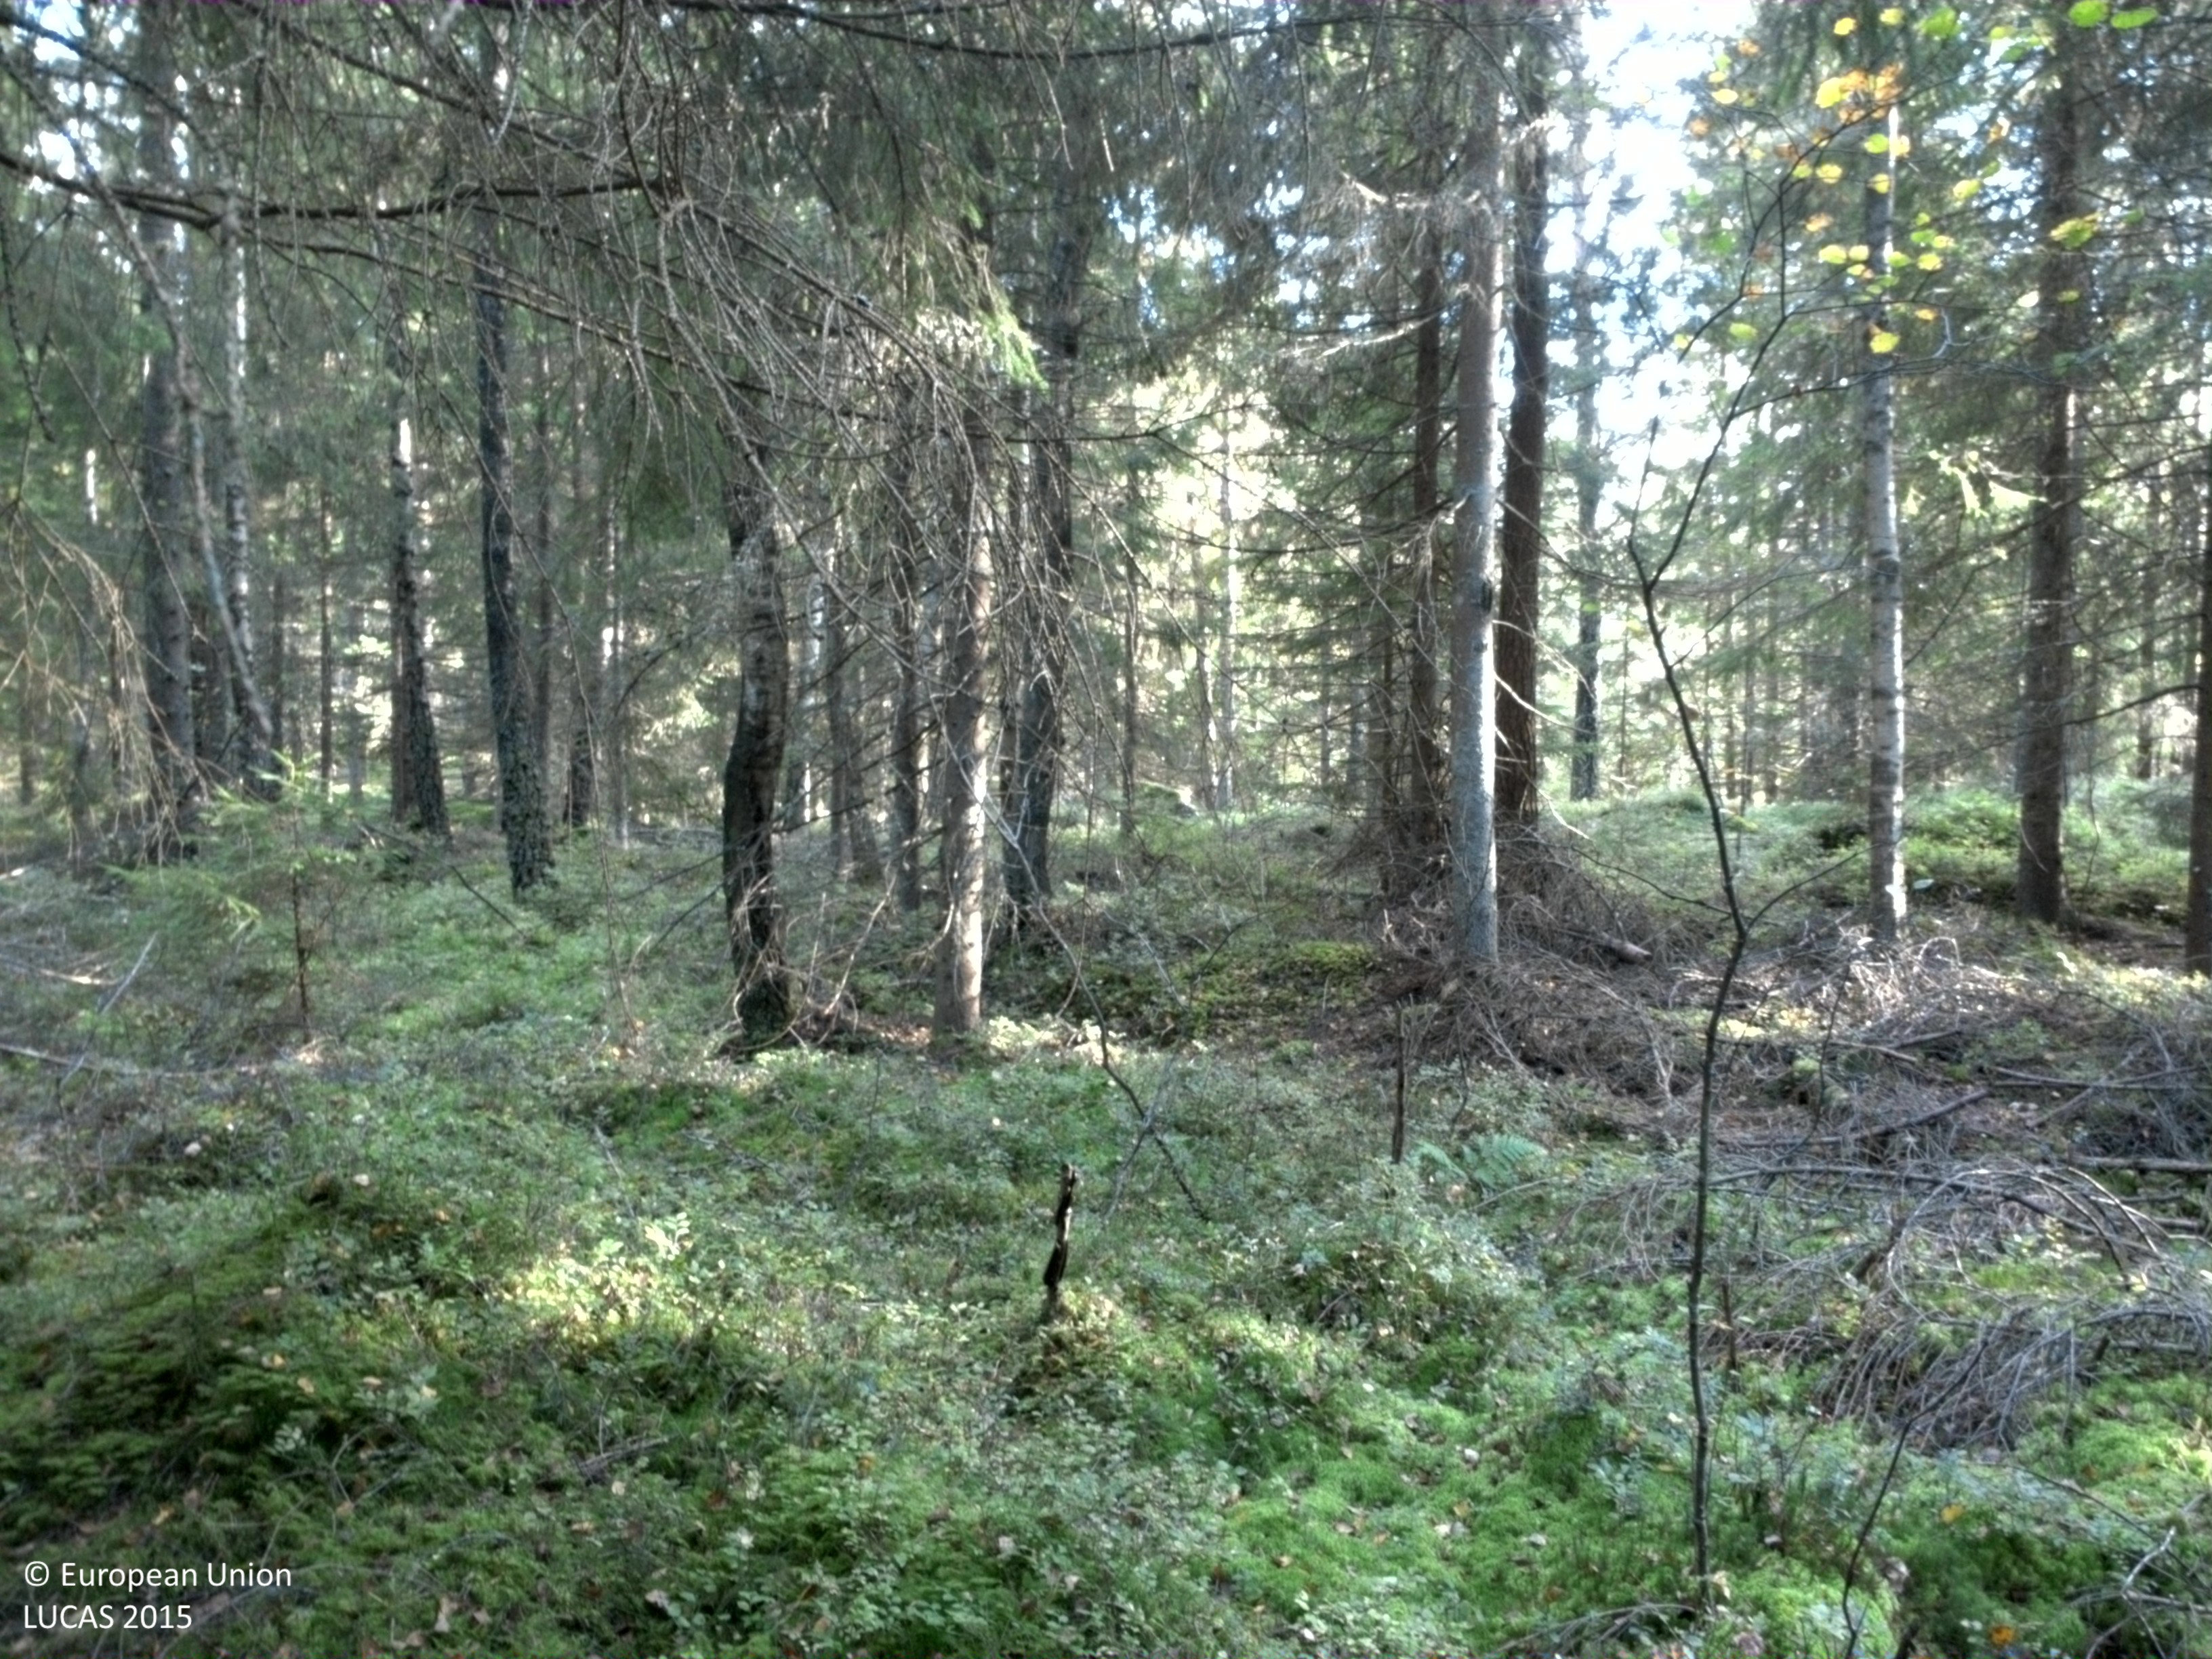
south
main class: Woodland
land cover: Spruce dominated mixed woodland
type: boreal forest
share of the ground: 50 - 75 %
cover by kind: coniferous forest trees 40 %, broadleaved forest trees 20 %, shrubs 20 %, lichens and mosses 20 %
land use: Forestry
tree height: > 5 m
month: September
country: SE
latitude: 57.8970
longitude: 13.0488
